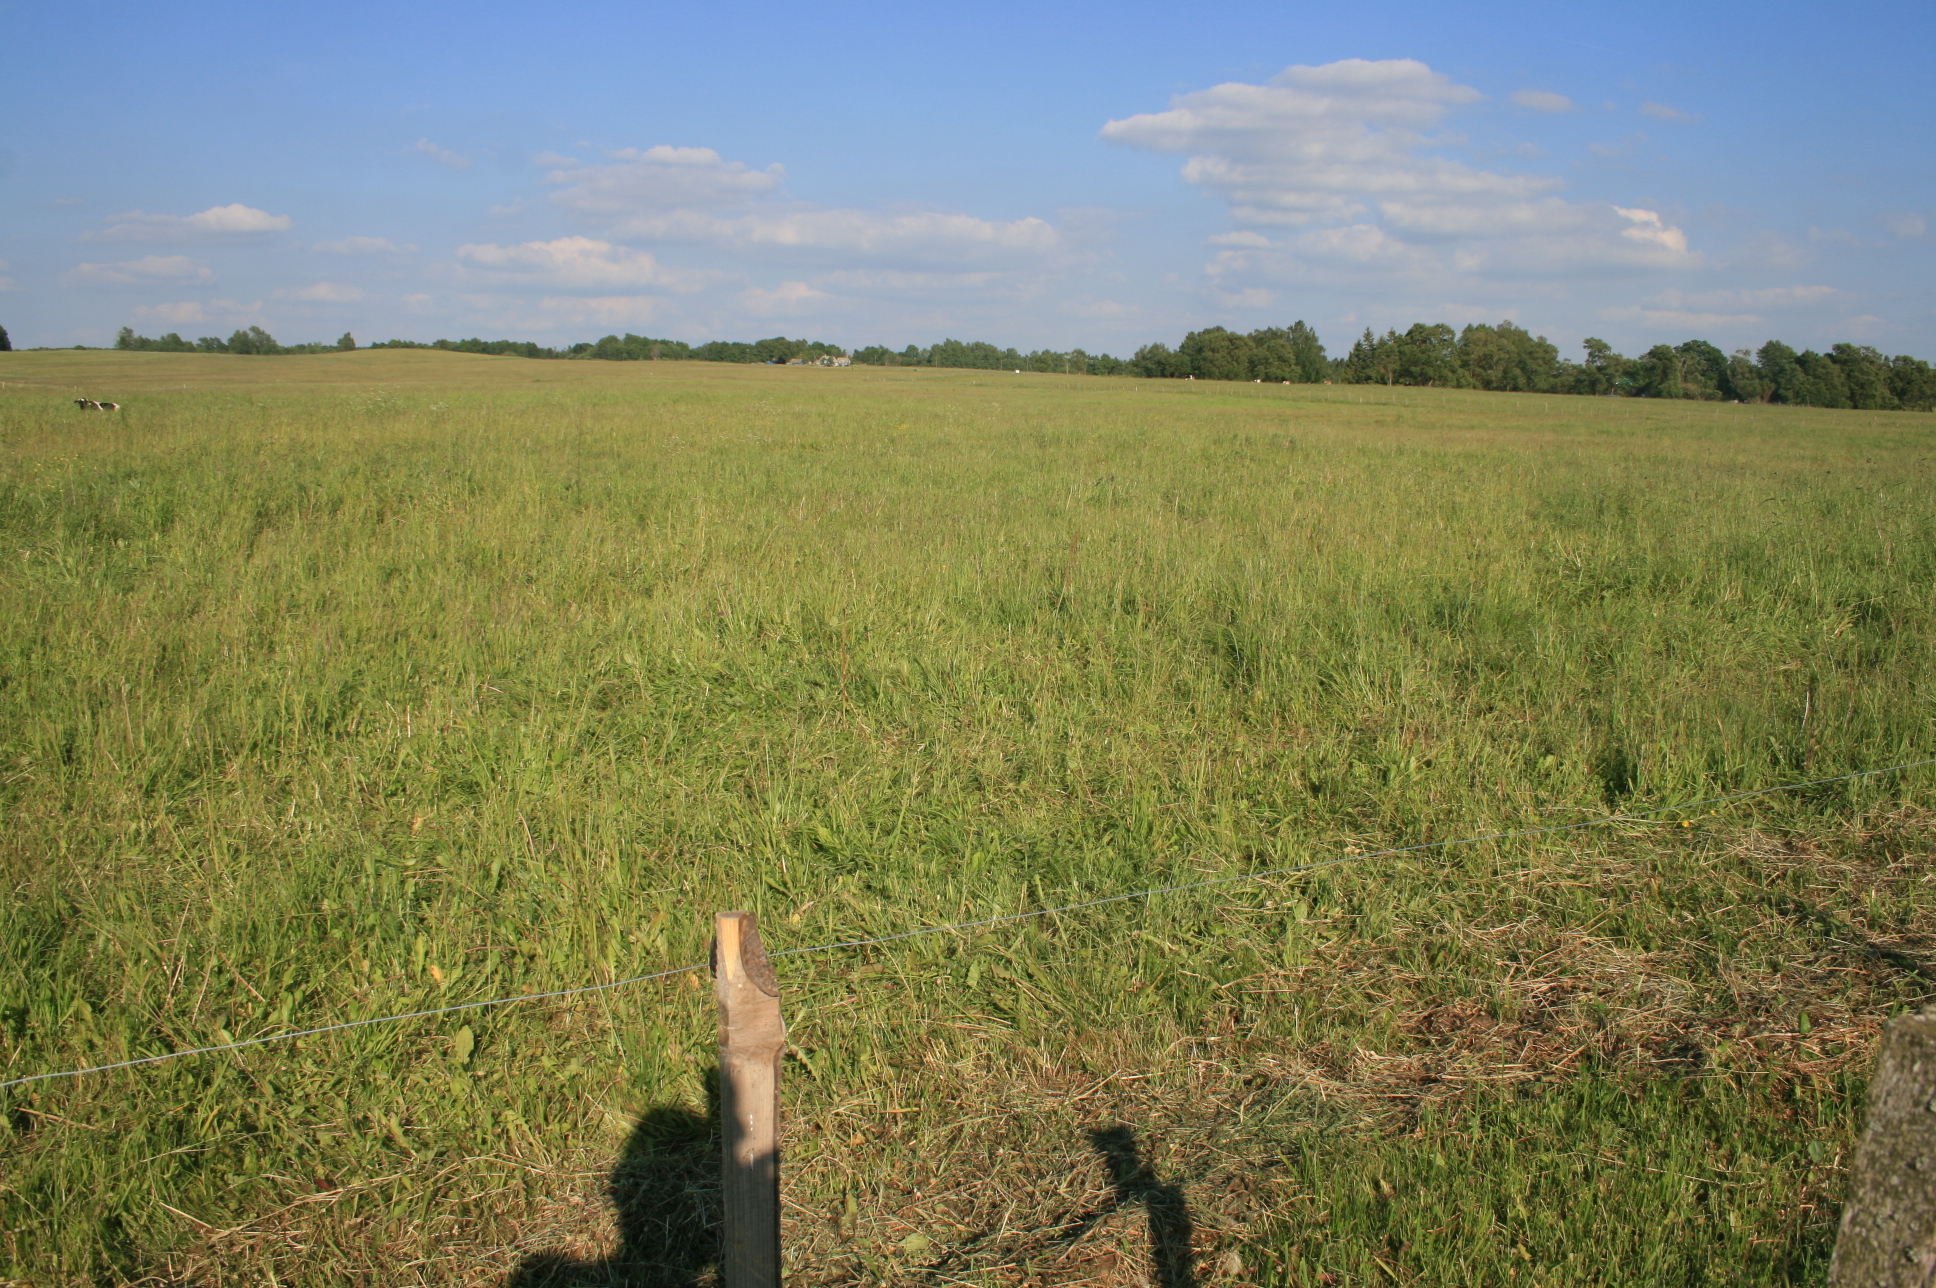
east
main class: Grassland
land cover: Grassland without tree/shrub cover
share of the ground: > 75 %
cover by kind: herbaceous plants 100 %
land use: Agriculture (excluding fallow land and kitchen gardens)
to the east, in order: Grassland without tree/shrub cover
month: June
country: LT
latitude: 55.6562
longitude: 22.2146
